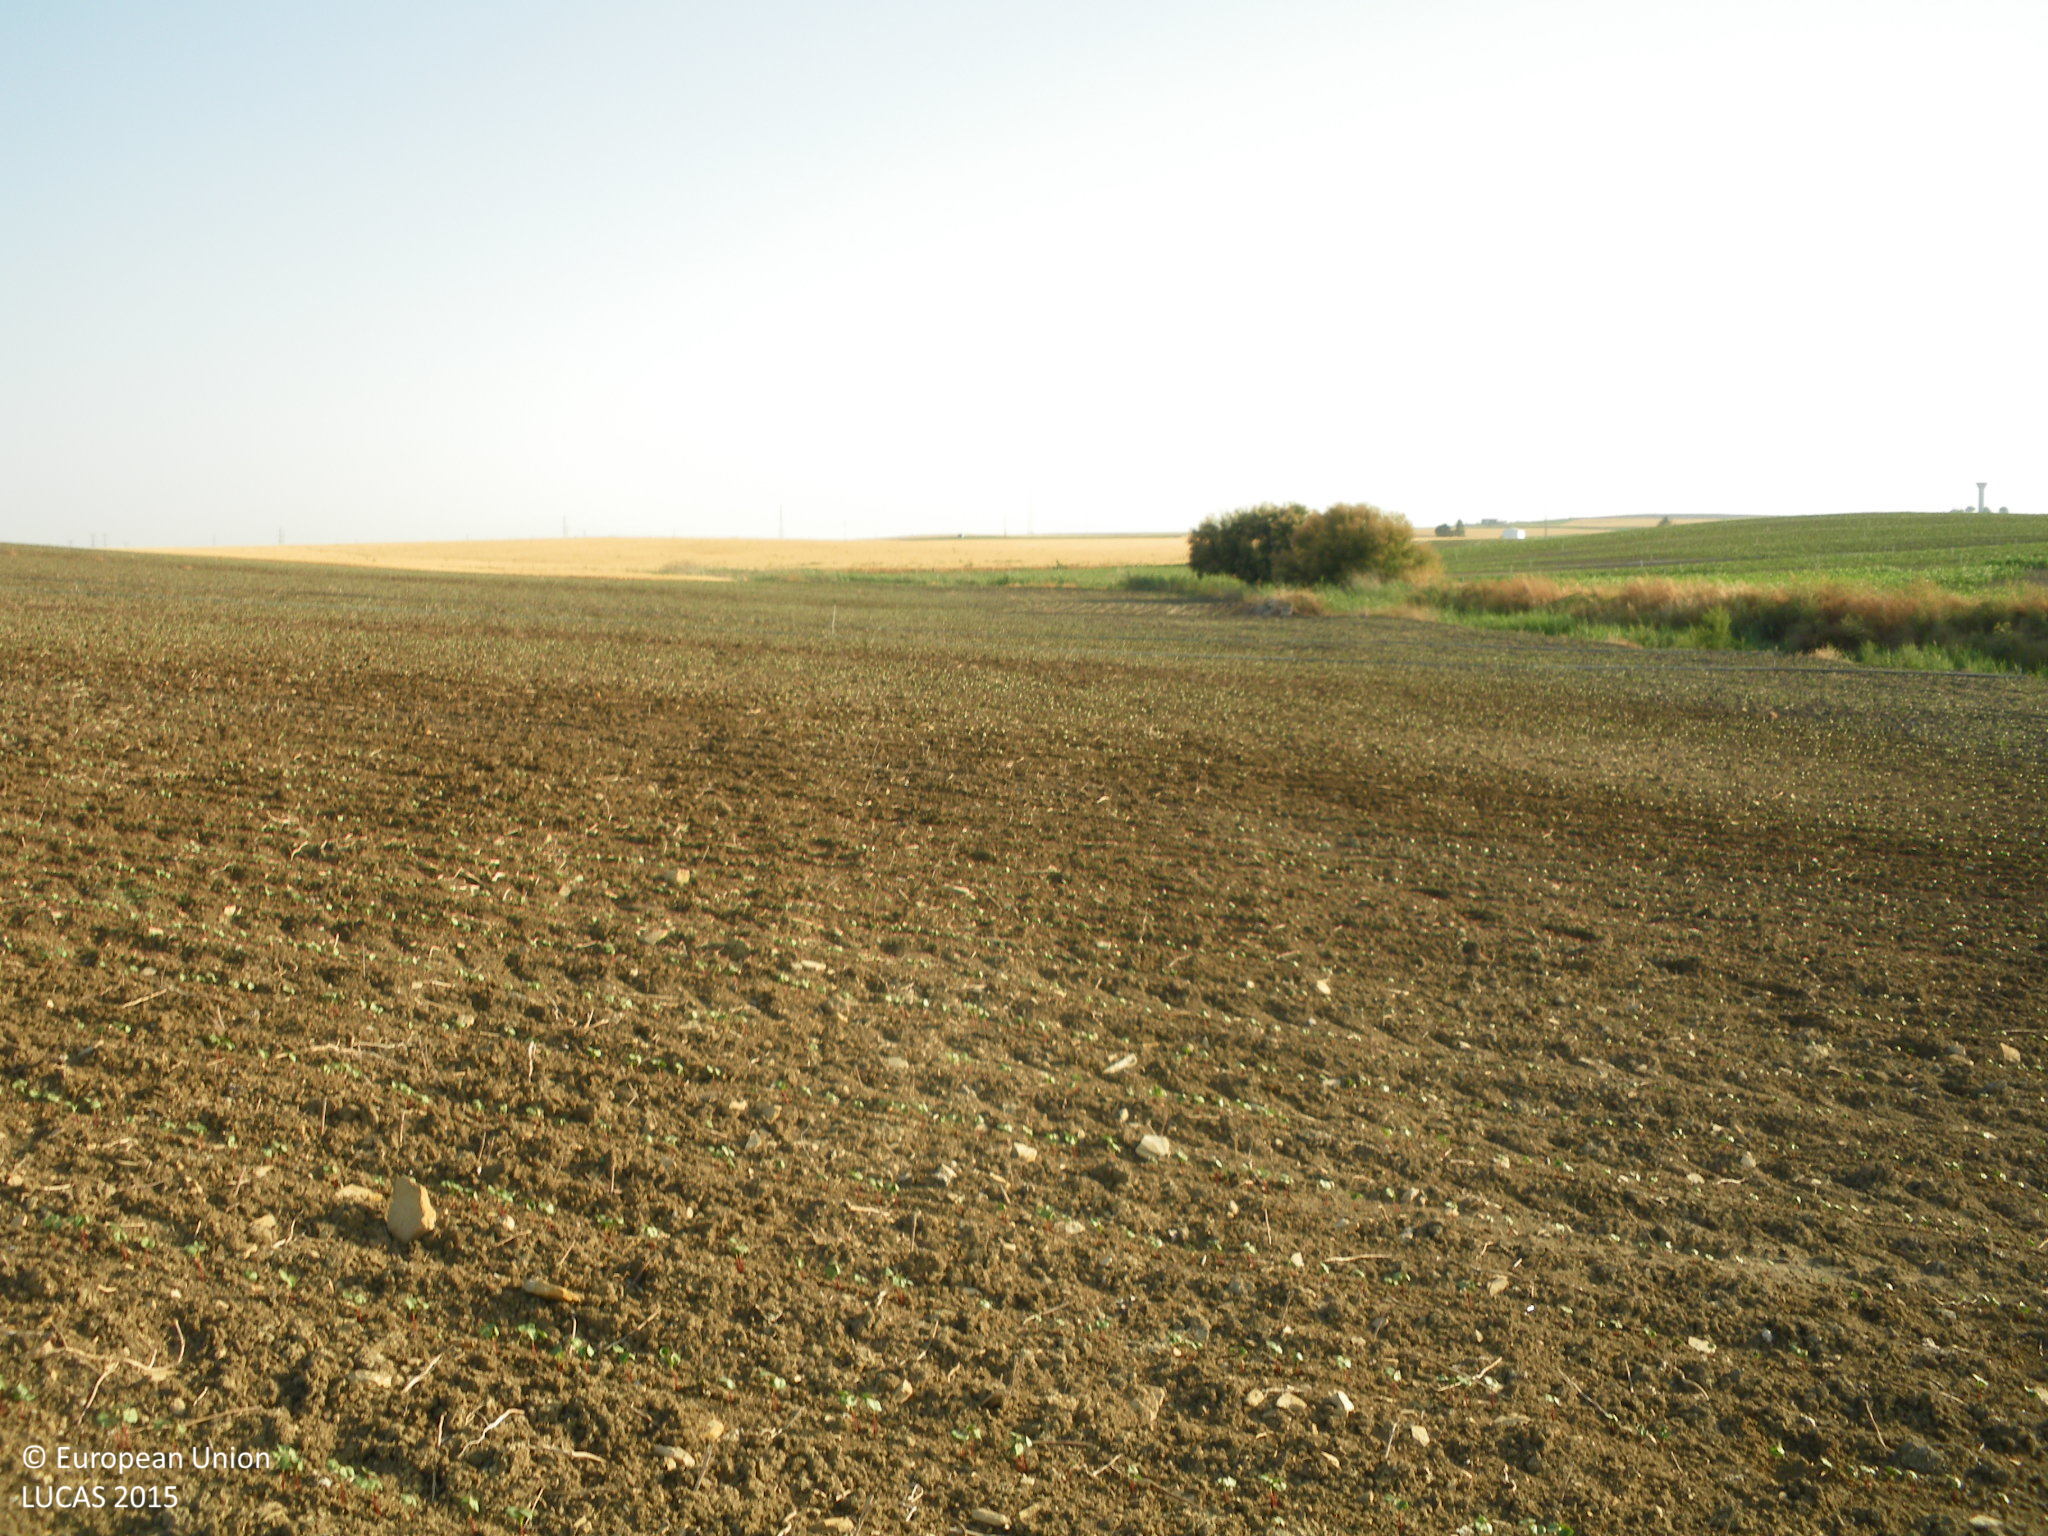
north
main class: Cropland
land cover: Cotton
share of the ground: < 10 %
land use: Agriculture (excluding fallow land and kitchen gardens)
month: June
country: ES
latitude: 36.6466
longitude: -6.2888
